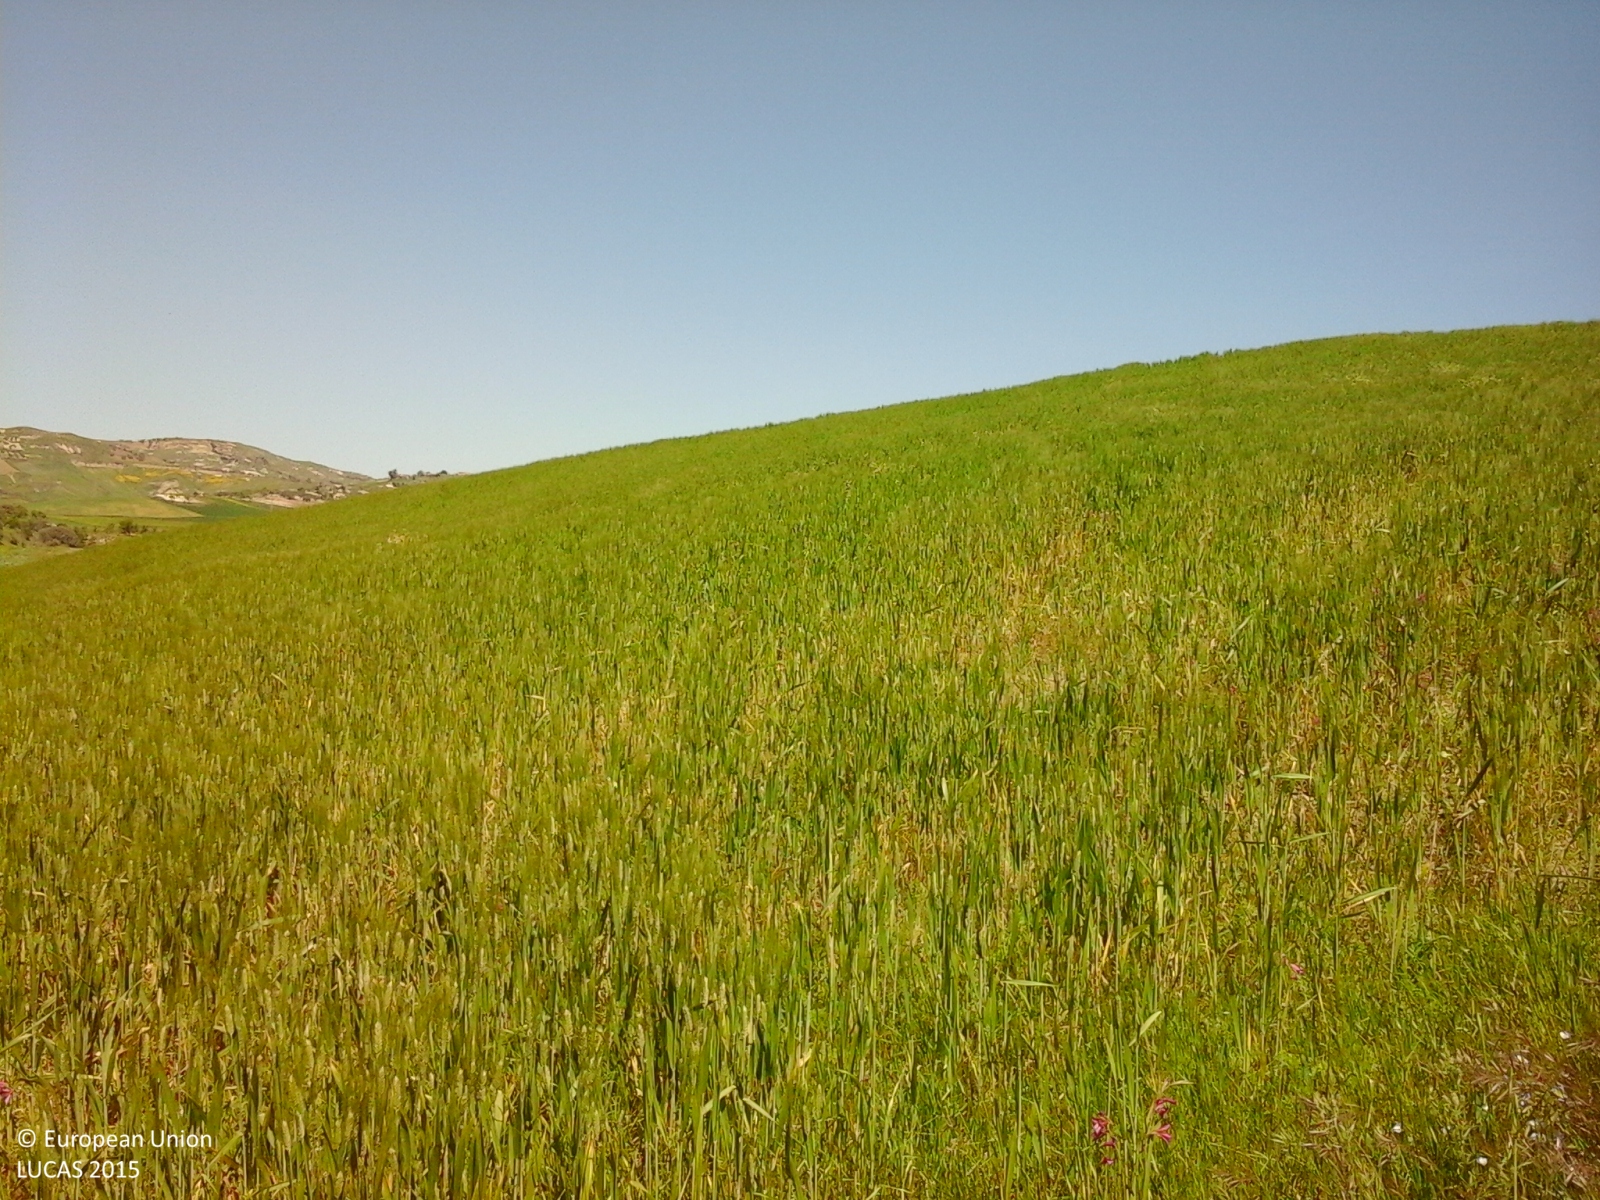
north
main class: Cropland
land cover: Durum wheat
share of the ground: > 75 %
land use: Agriculture (excluding fallow land and kitchen gardens)
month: April
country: IT
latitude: 37.4077
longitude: 13.5764
